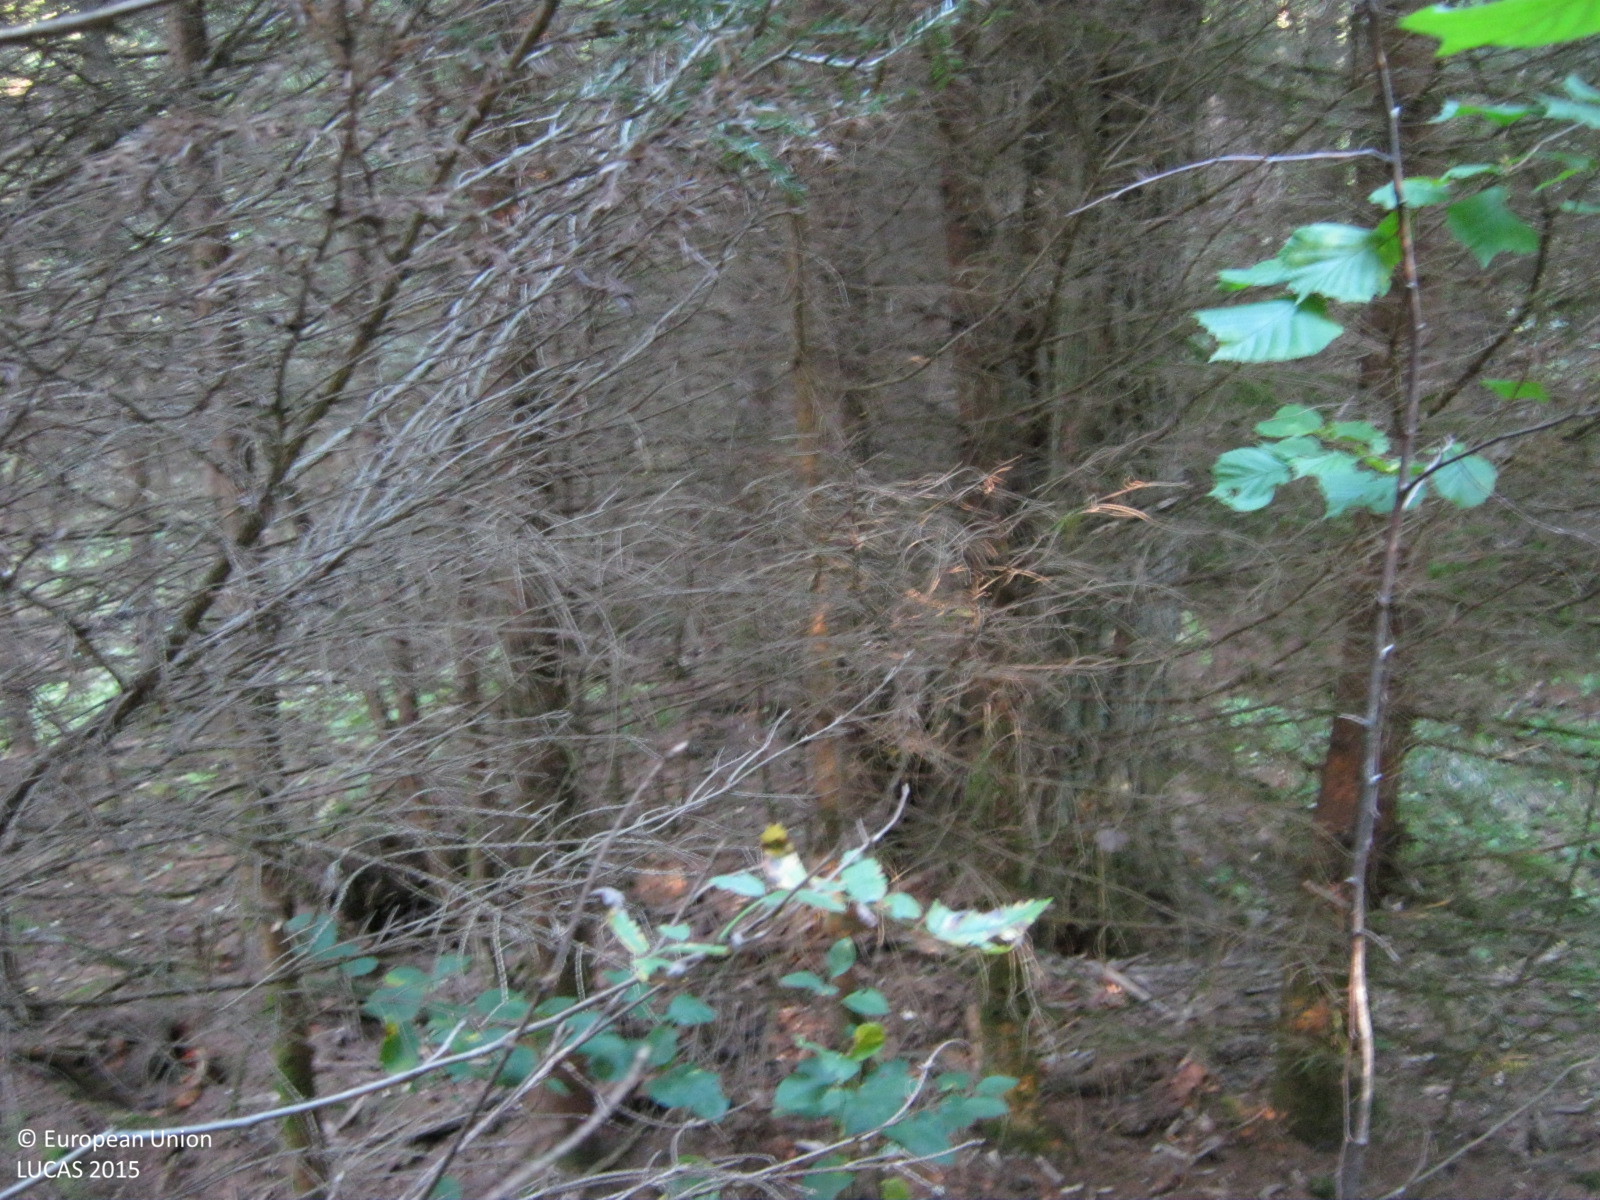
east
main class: Woodland
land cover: Spruce dominated coniferous woodland
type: hemiboreal forest and nemoral coniferous forest and mixed broadleaved-coniferous forest
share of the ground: > 75 %
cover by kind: coniferous forest trees 90 %, herbaceous plants 5 %, lichens and mosses 5 %
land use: Forestry
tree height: > 5 m
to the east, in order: Spruce dominated coniferous woodland; Spruce dominated mixed woodland; Broadleaved woodland; Grassland without tree/shrub cover; Spruce dominated mixed woodland; Broadleaved woodland
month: September
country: LV
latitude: 57.2929
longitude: 24.7158
